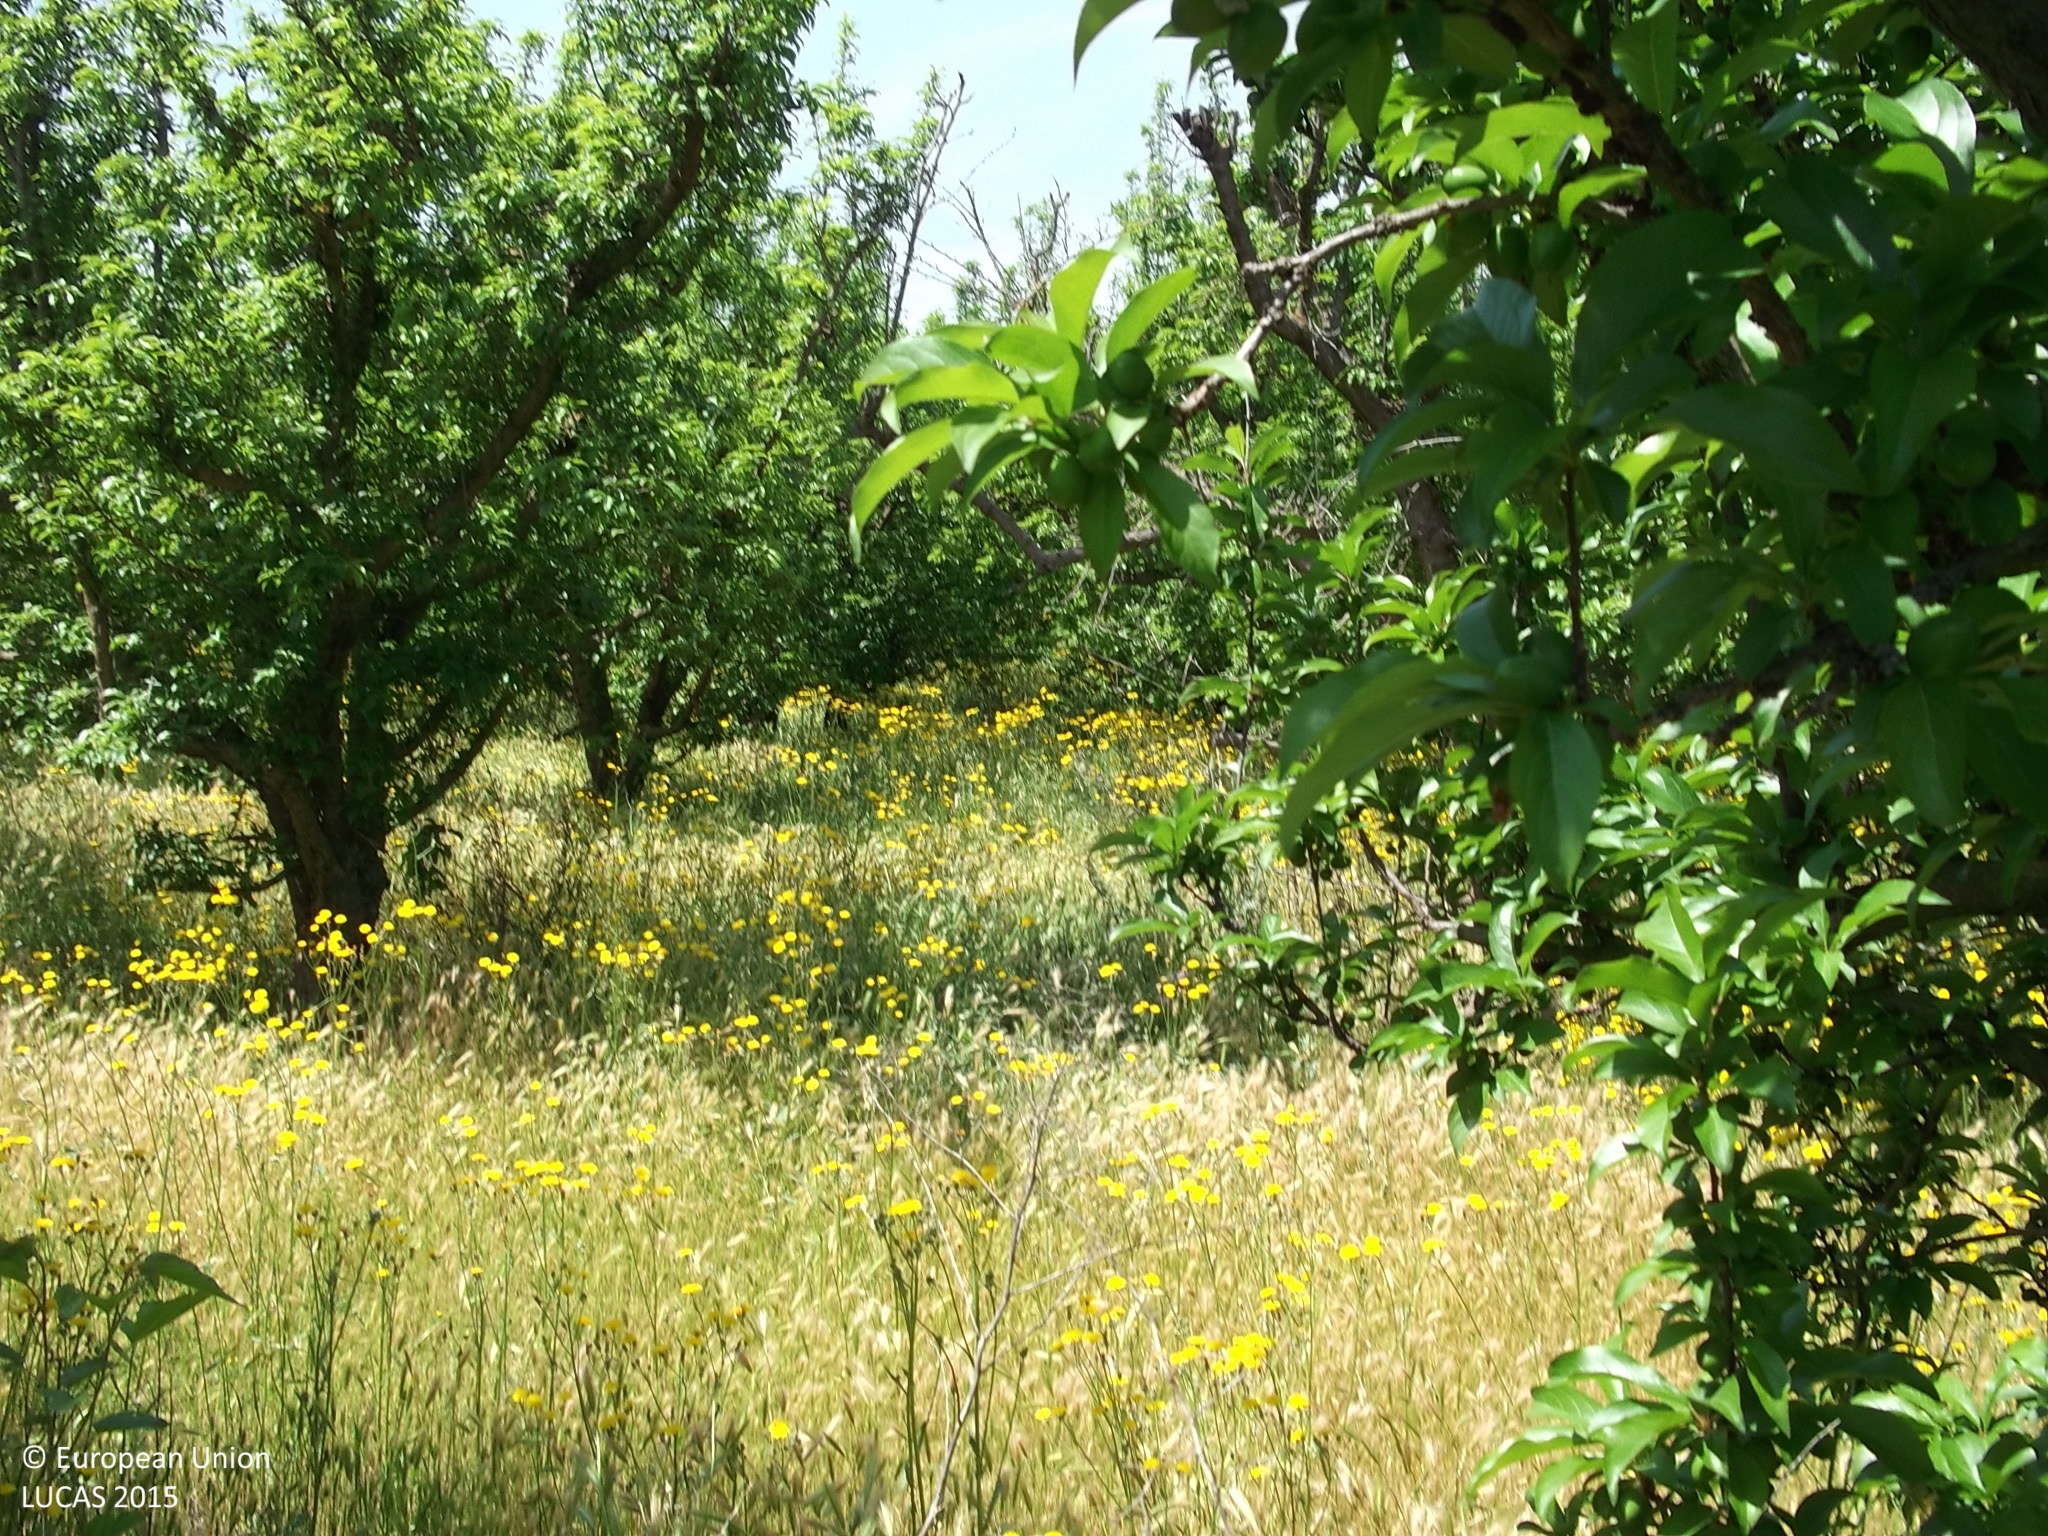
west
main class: Cropland
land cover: Other fruit trees and berries
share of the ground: 25 - 50 %
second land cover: Spontaneously vegetated surfaces
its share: 50 - 75 %
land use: Agriculture (excluding fallow land and kitchen gardens)
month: April
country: ES
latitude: 38.2595
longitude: -1.6124
